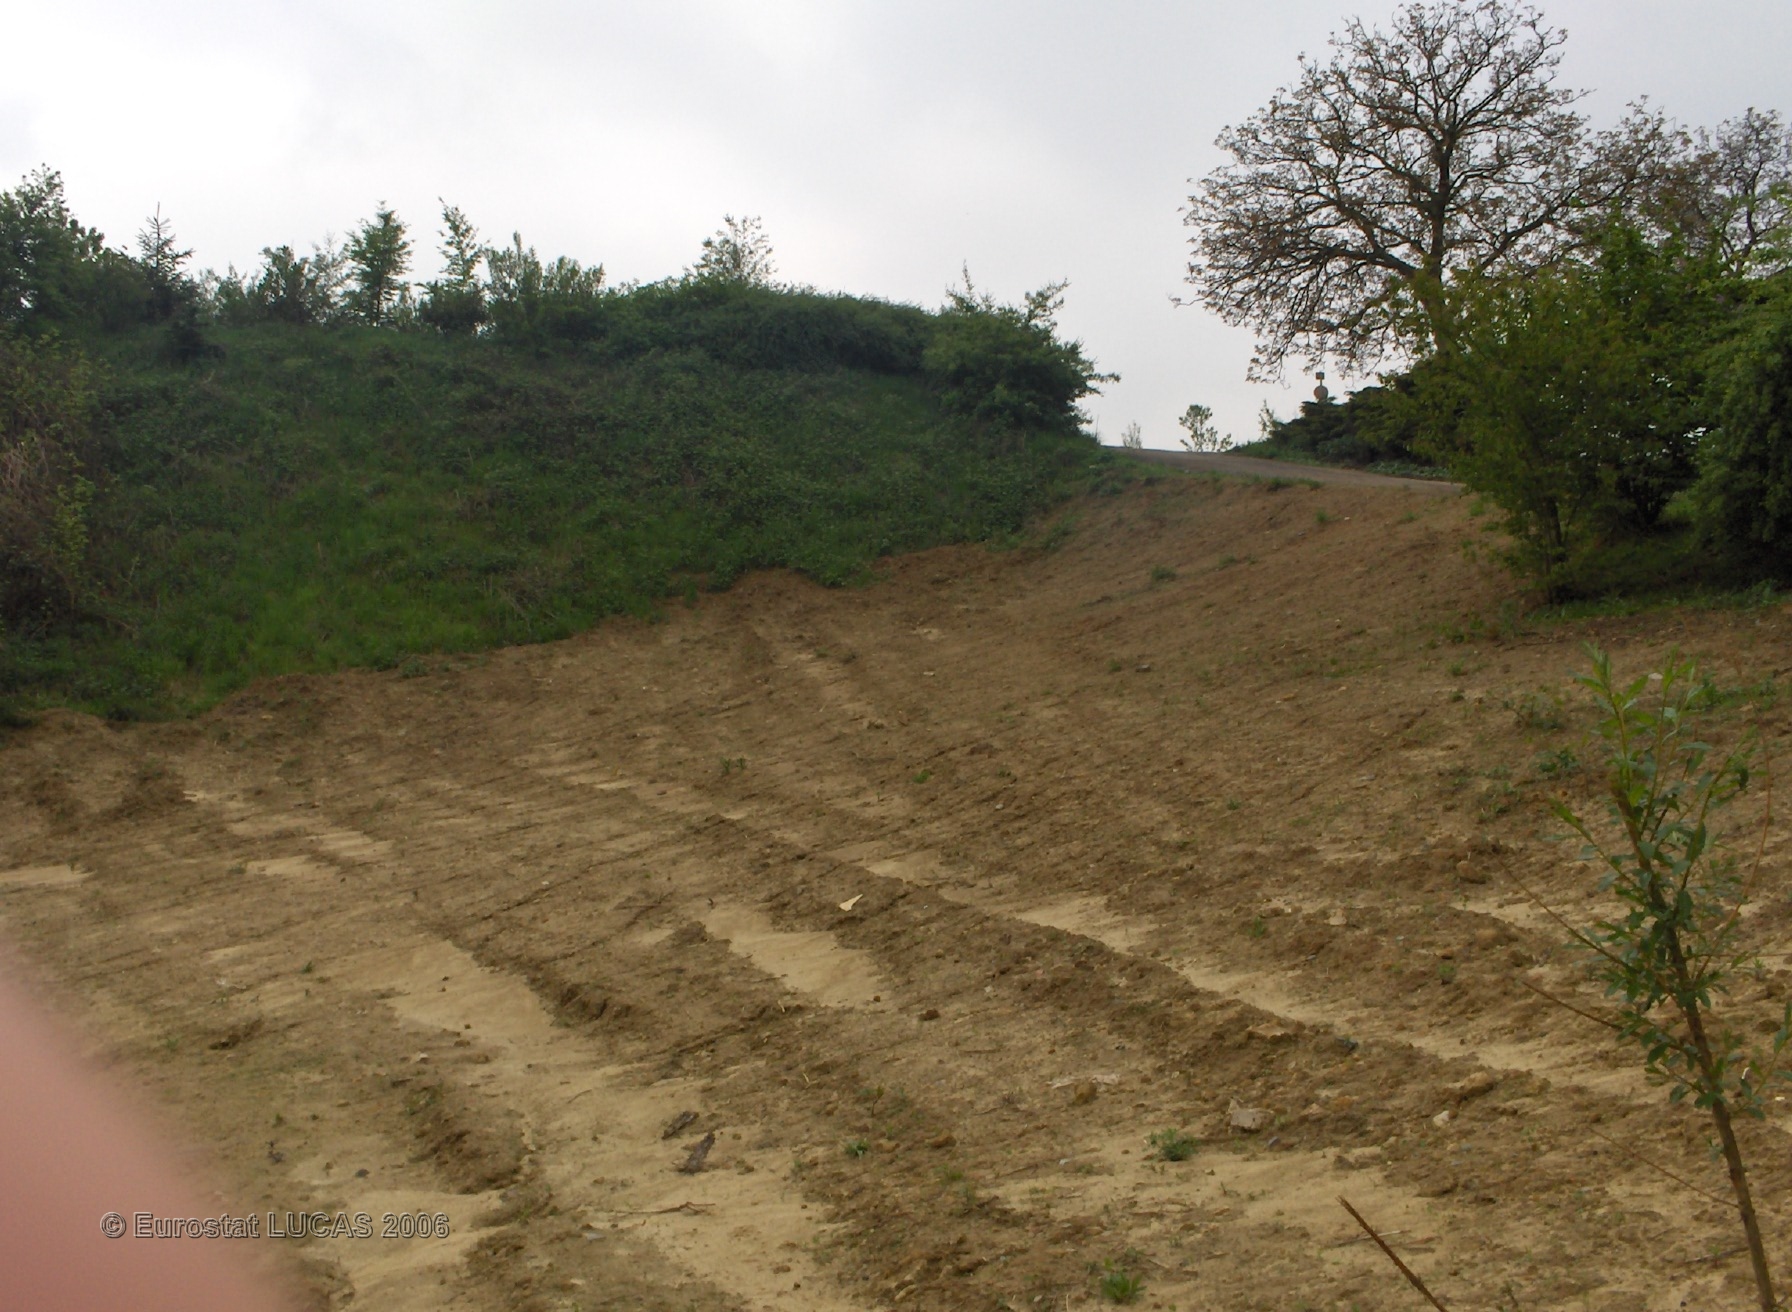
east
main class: Water areas
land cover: Inland water bodies
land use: Unused
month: May
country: BE
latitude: 50.5591
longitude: 4.5613
